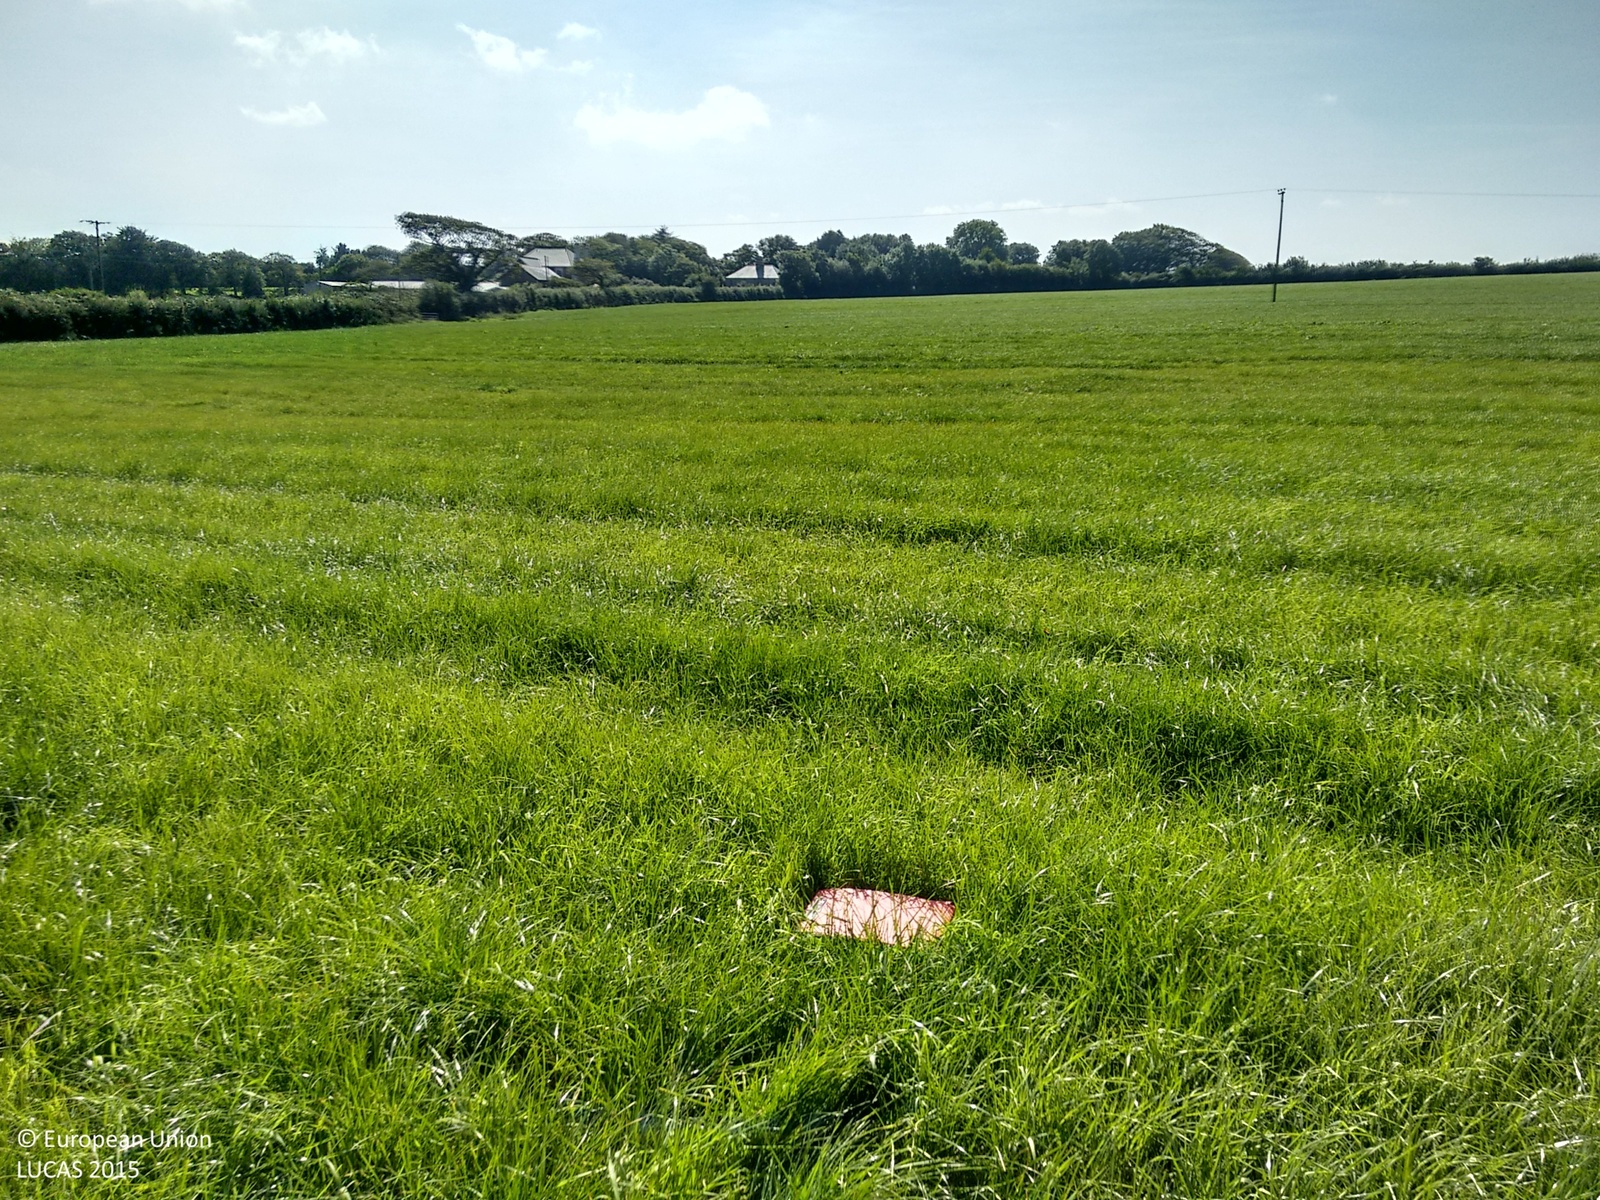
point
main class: Cropland
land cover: Temporary grasslands
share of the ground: > 75 %
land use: Agriculture (excluding fallow land and kitchen gardens)
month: September
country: GB
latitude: 50.8596
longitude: -4.2058
